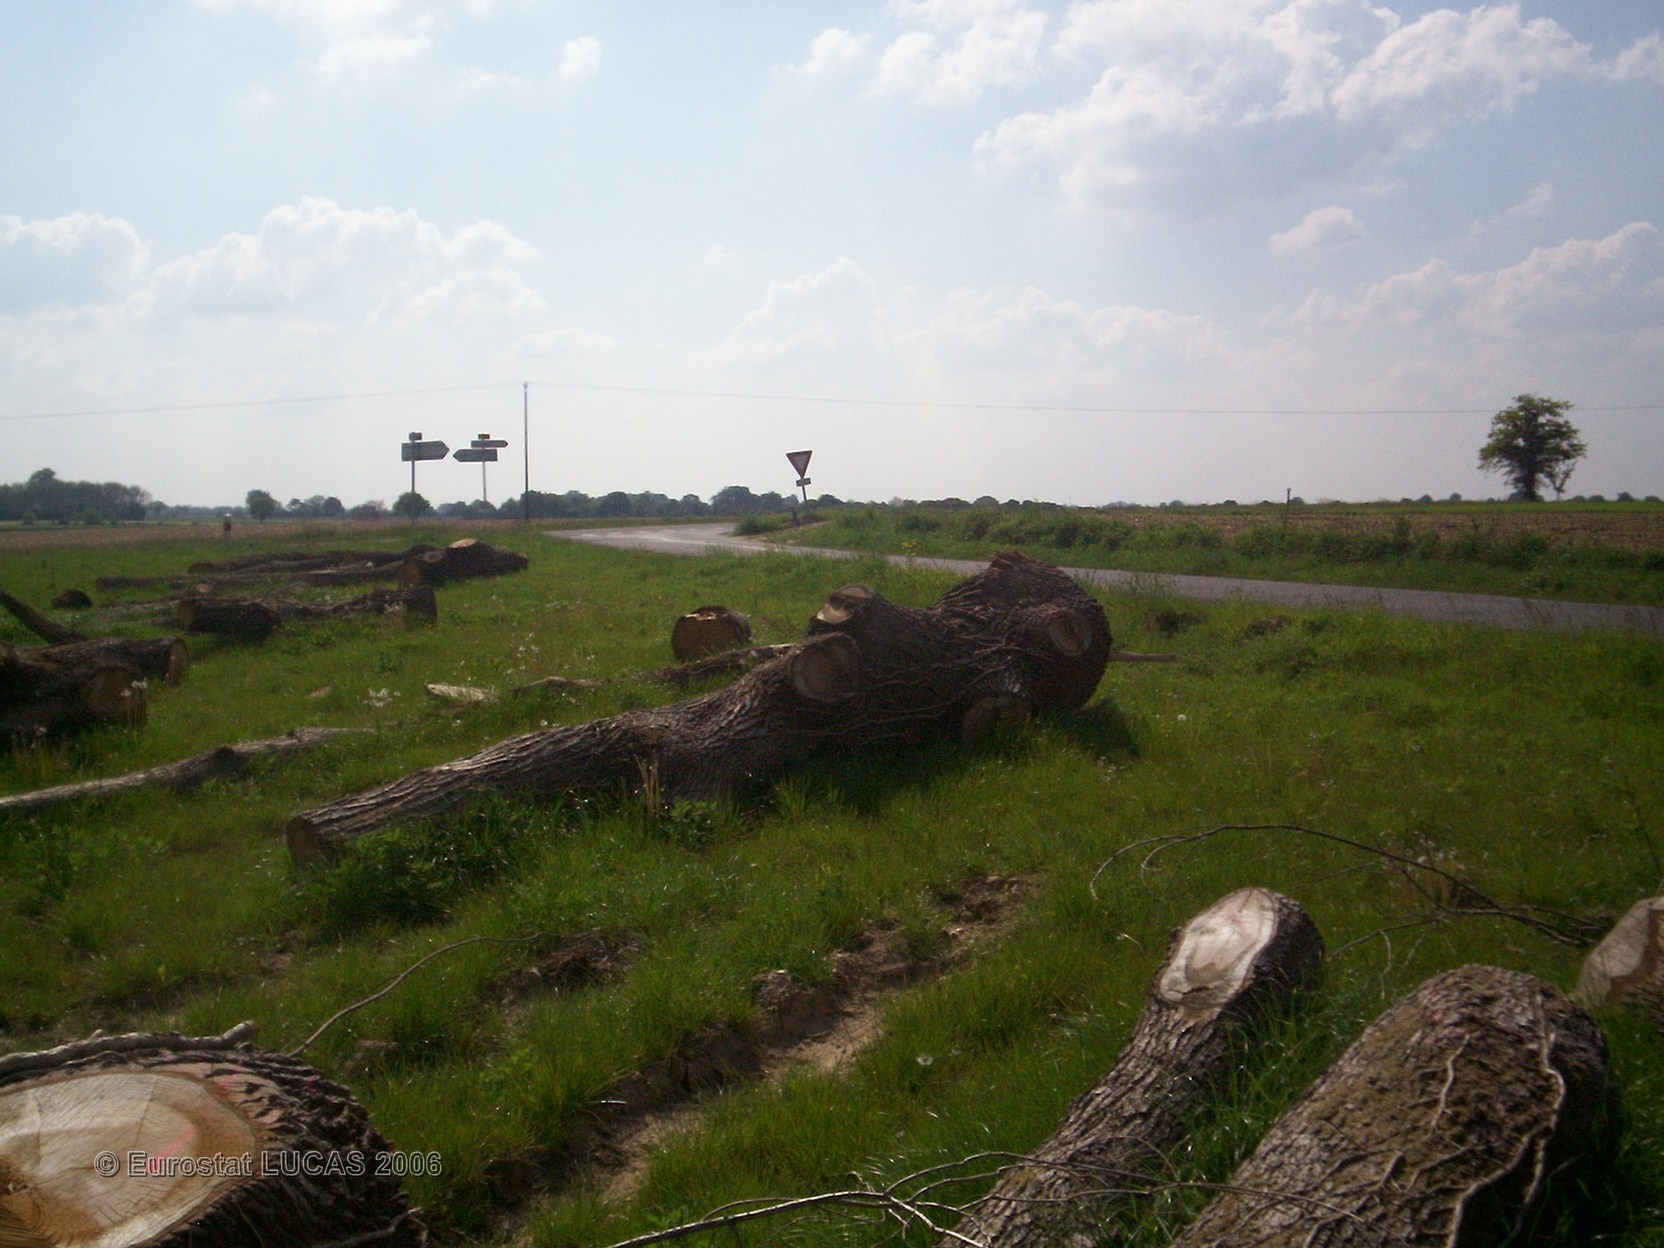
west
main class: Grassland
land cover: Grassland without tree/shrub cover
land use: Agriculture (excluding fallow land and kitchen gardens)
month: May
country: FR
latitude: 47.6224
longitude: 0.1954
